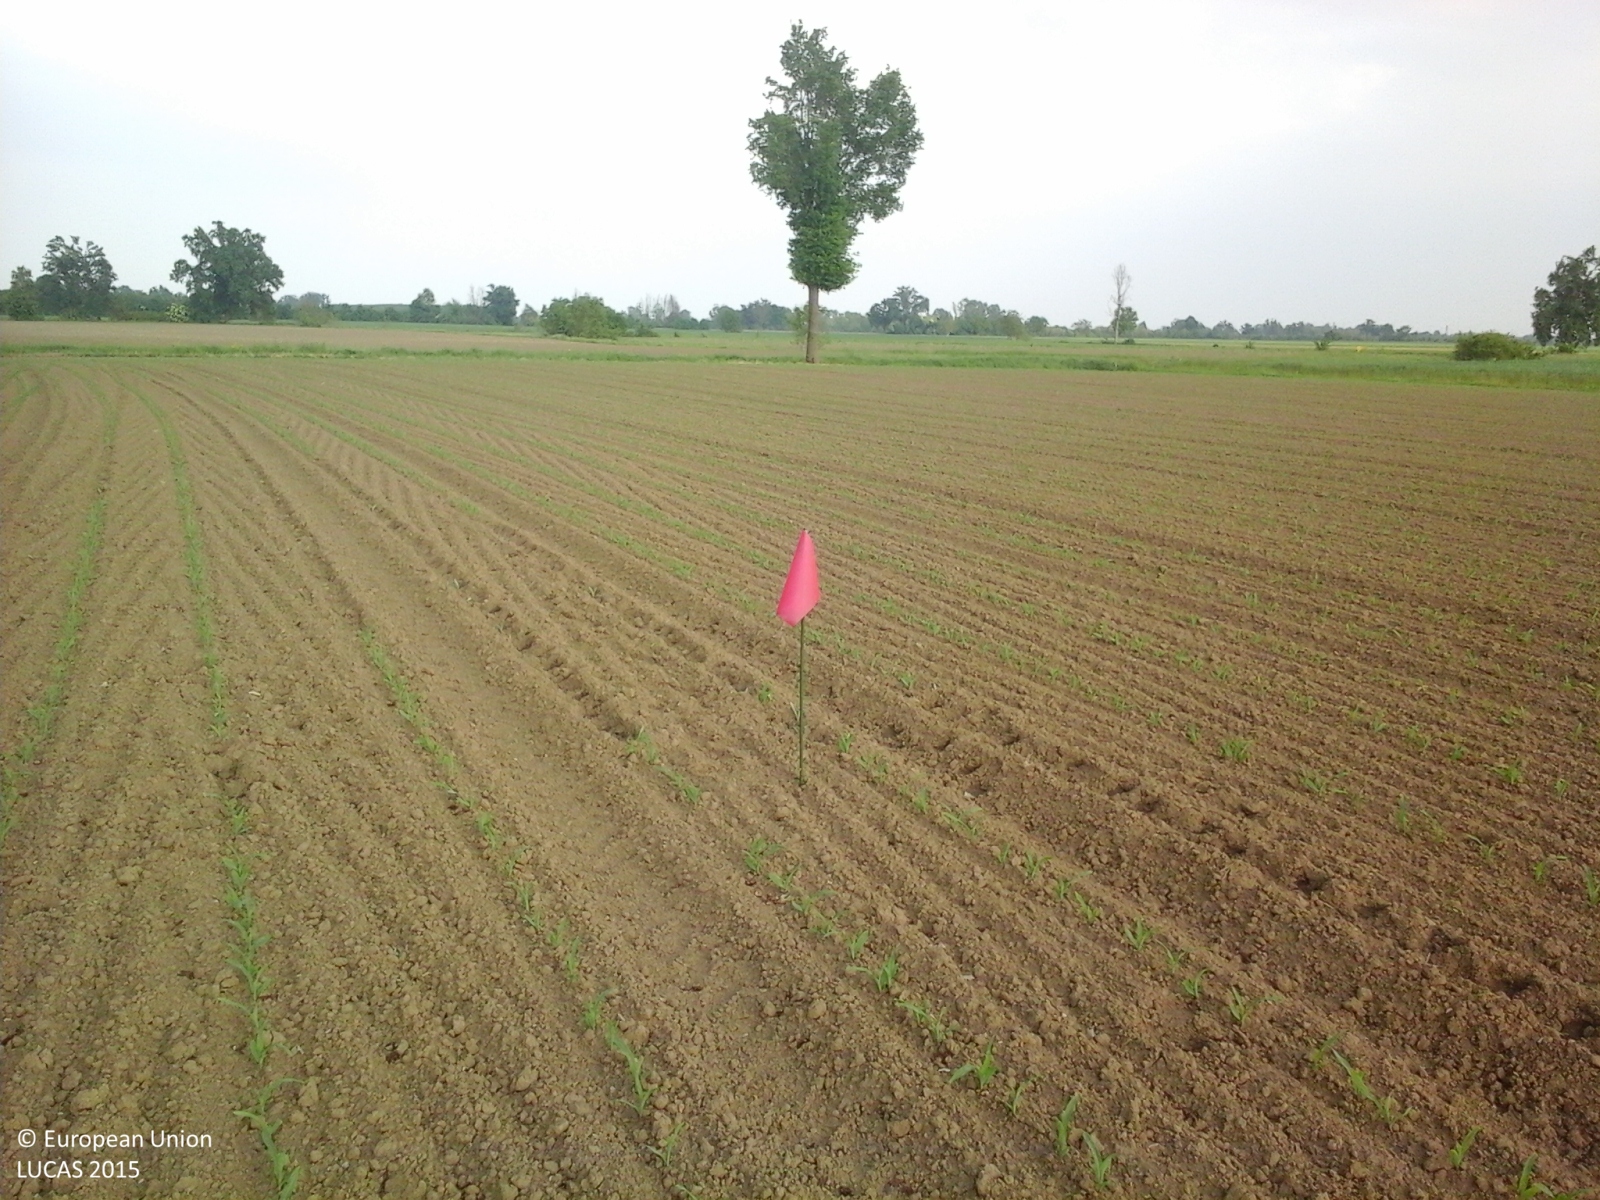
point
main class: Cropland
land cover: Maize
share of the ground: < 10 %
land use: Agriculture (excluding fallow land and kitchen gardens)
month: May
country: IT
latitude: 45.0350
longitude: 10.3927
